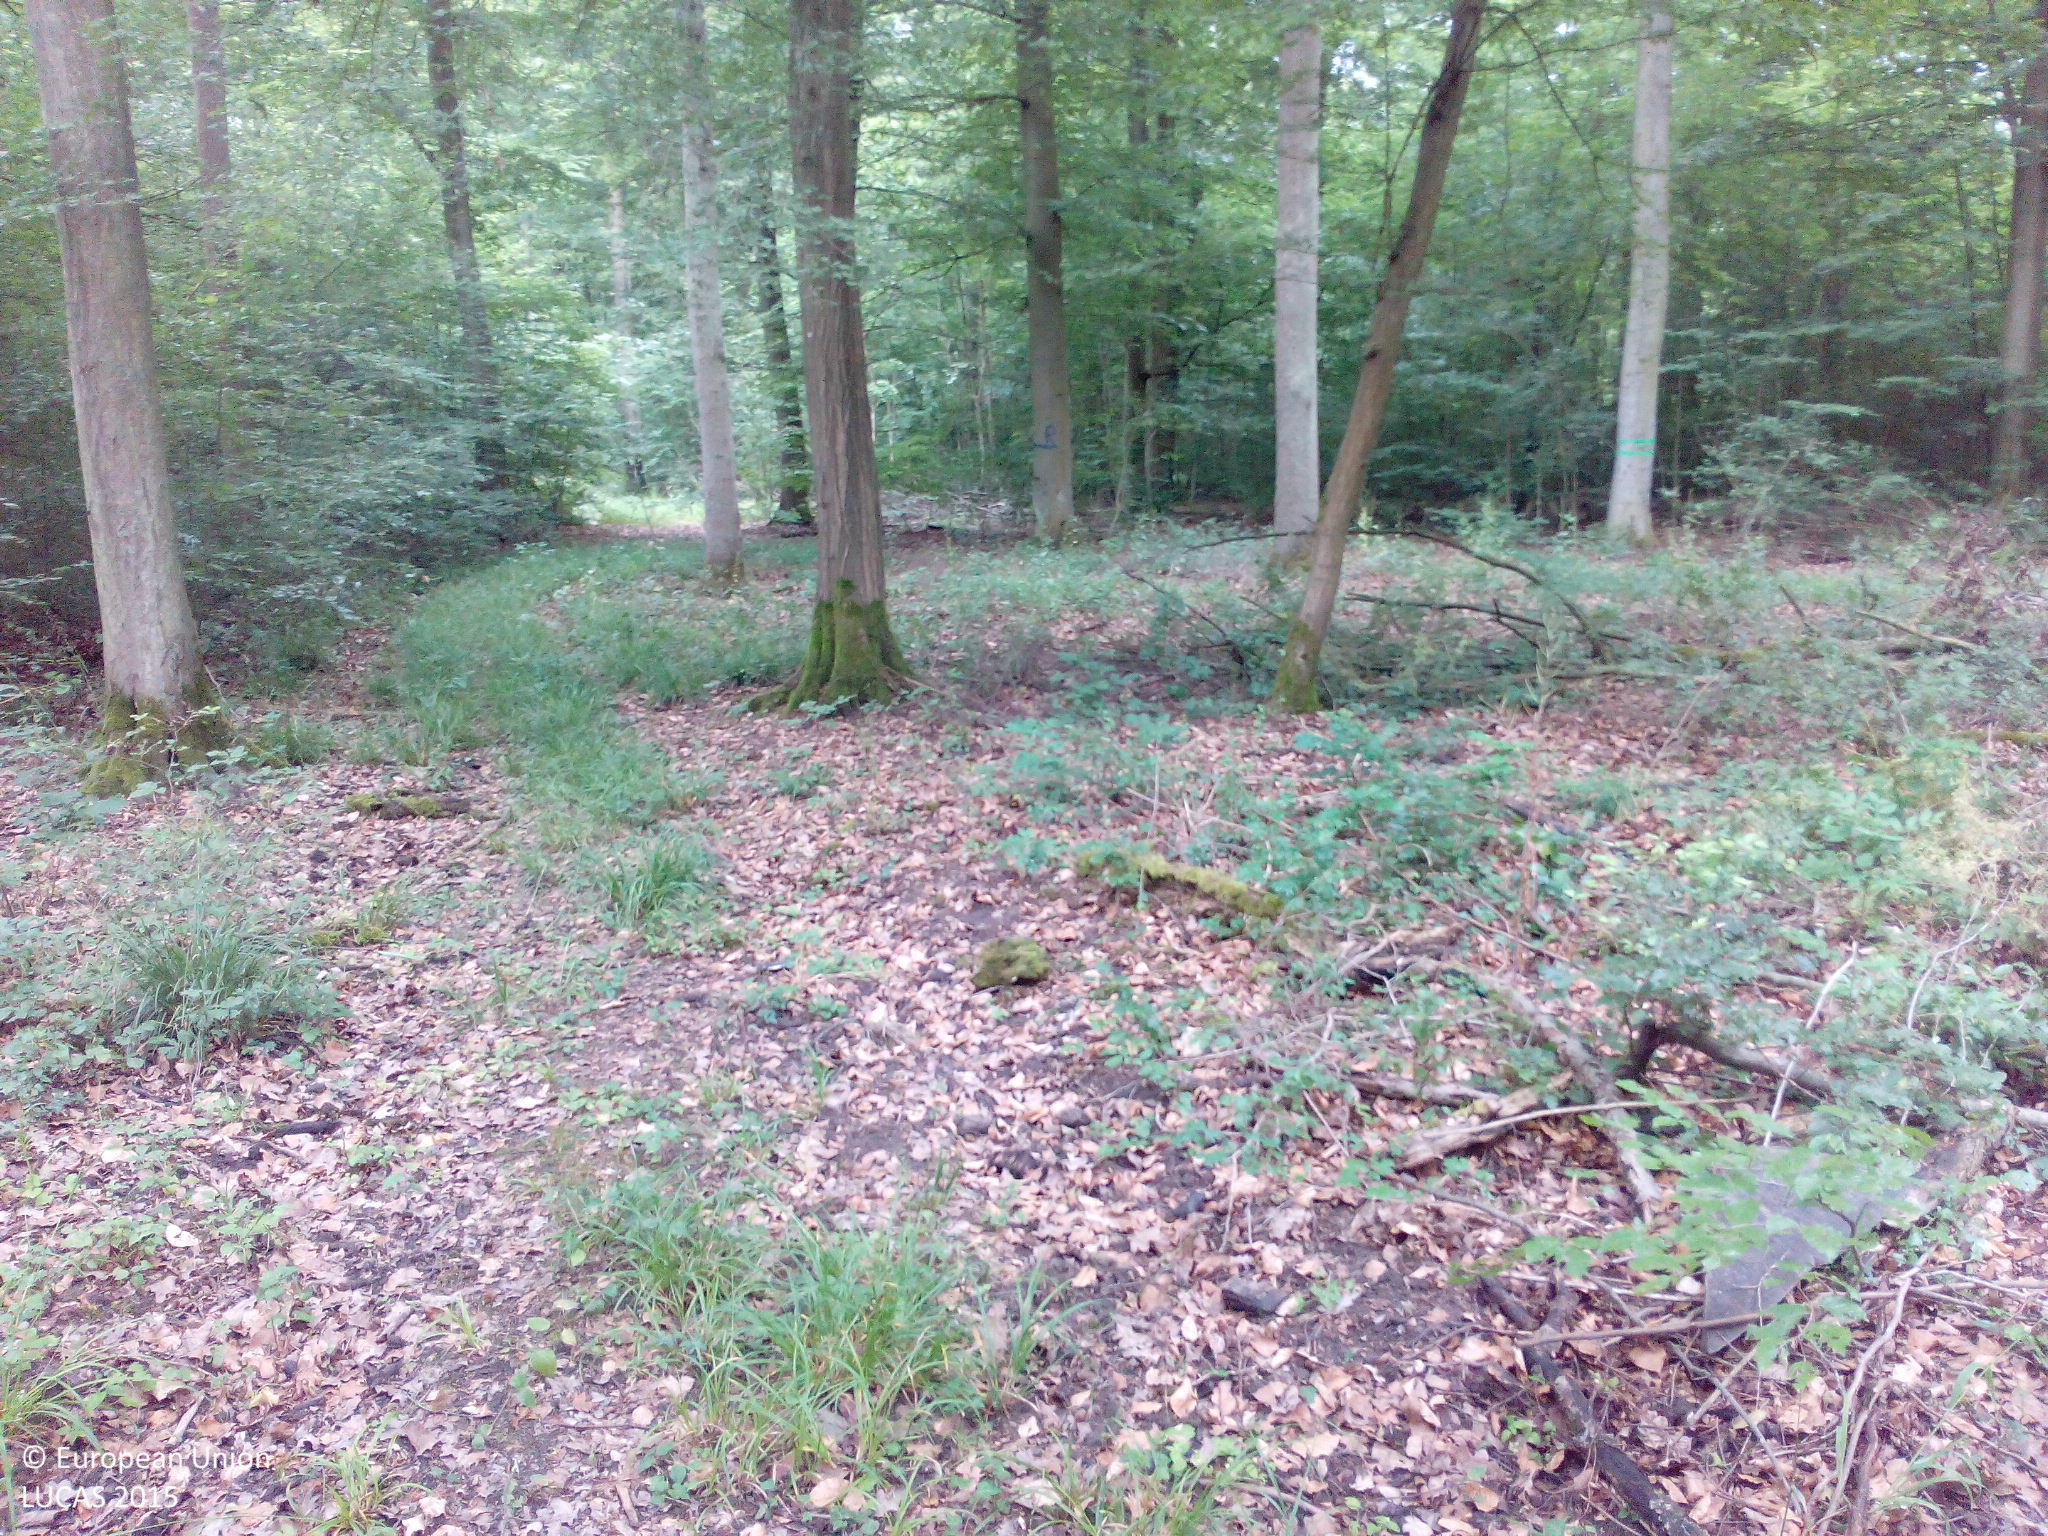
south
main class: Woodland
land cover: Broadleaved woodland
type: mesophytic deciduous forest
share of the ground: 50 - 75 %
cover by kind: broadleaved forest trees 60 %, herbaceous plants 20 %, shrubs 10 %, unconsolidated bare surface 10 %
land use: Forestry
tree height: > 5 m
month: June
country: DE
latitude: 49.7073
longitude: 8.5444
